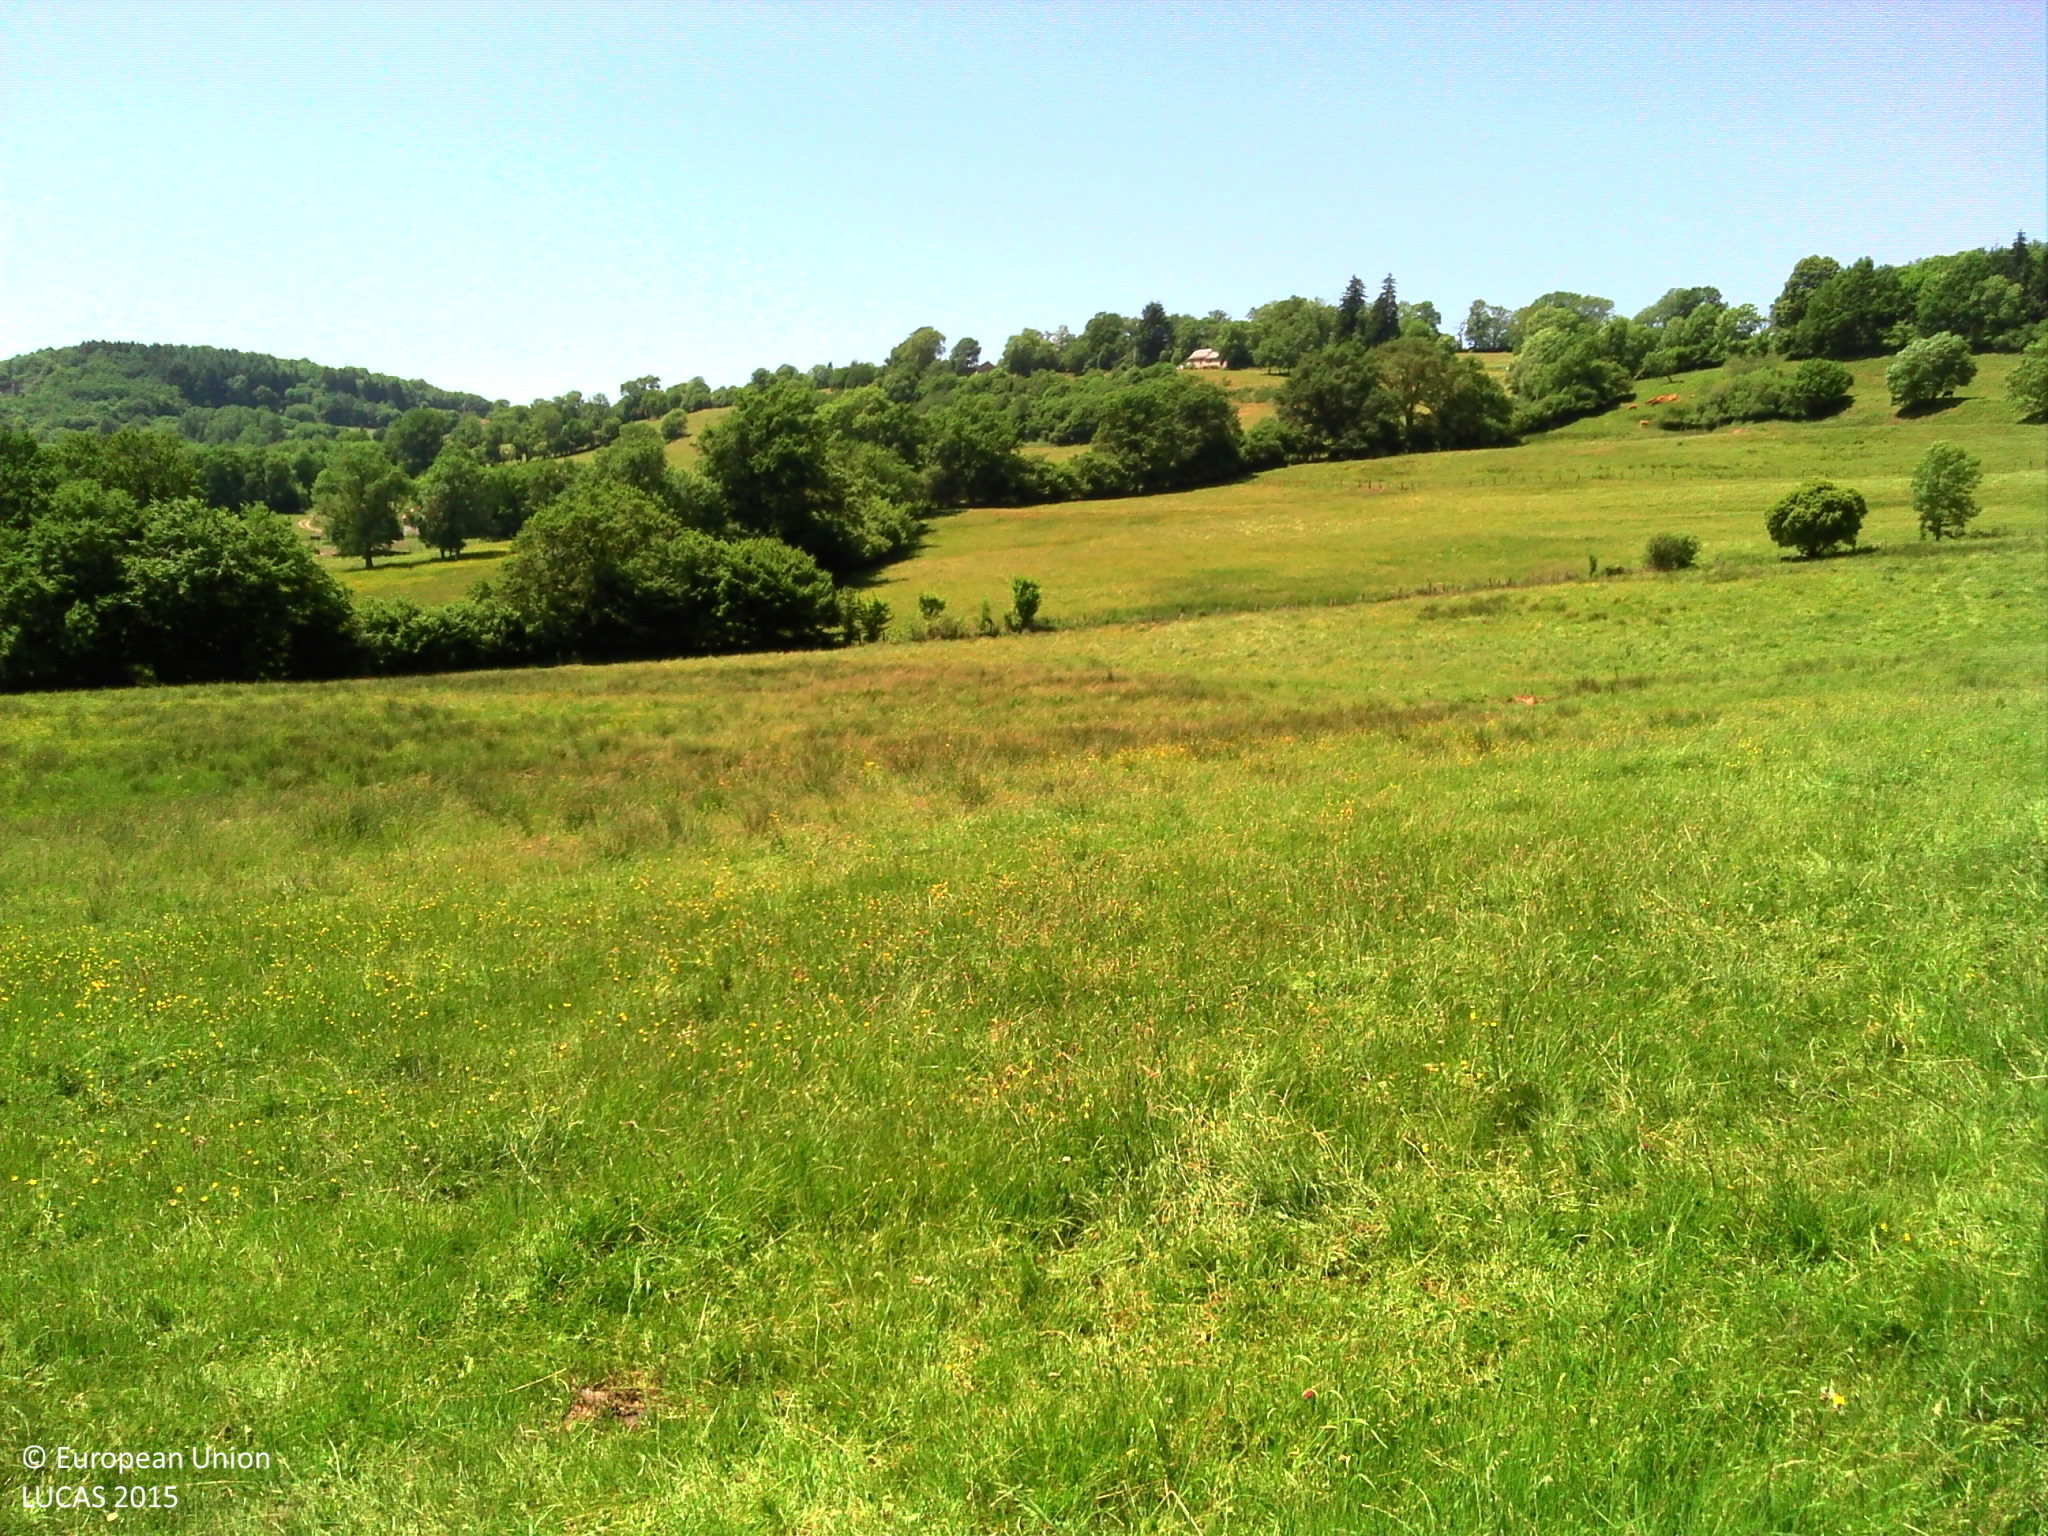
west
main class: Grassland
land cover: Grassland without tree/shrub cover
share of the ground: > 75 %
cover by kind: herbaceous plants 100 %
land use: Agriculture (excluding fallow land and kitchen gardens)
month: June
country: FR
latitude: 45.3590
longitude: 2.4286
